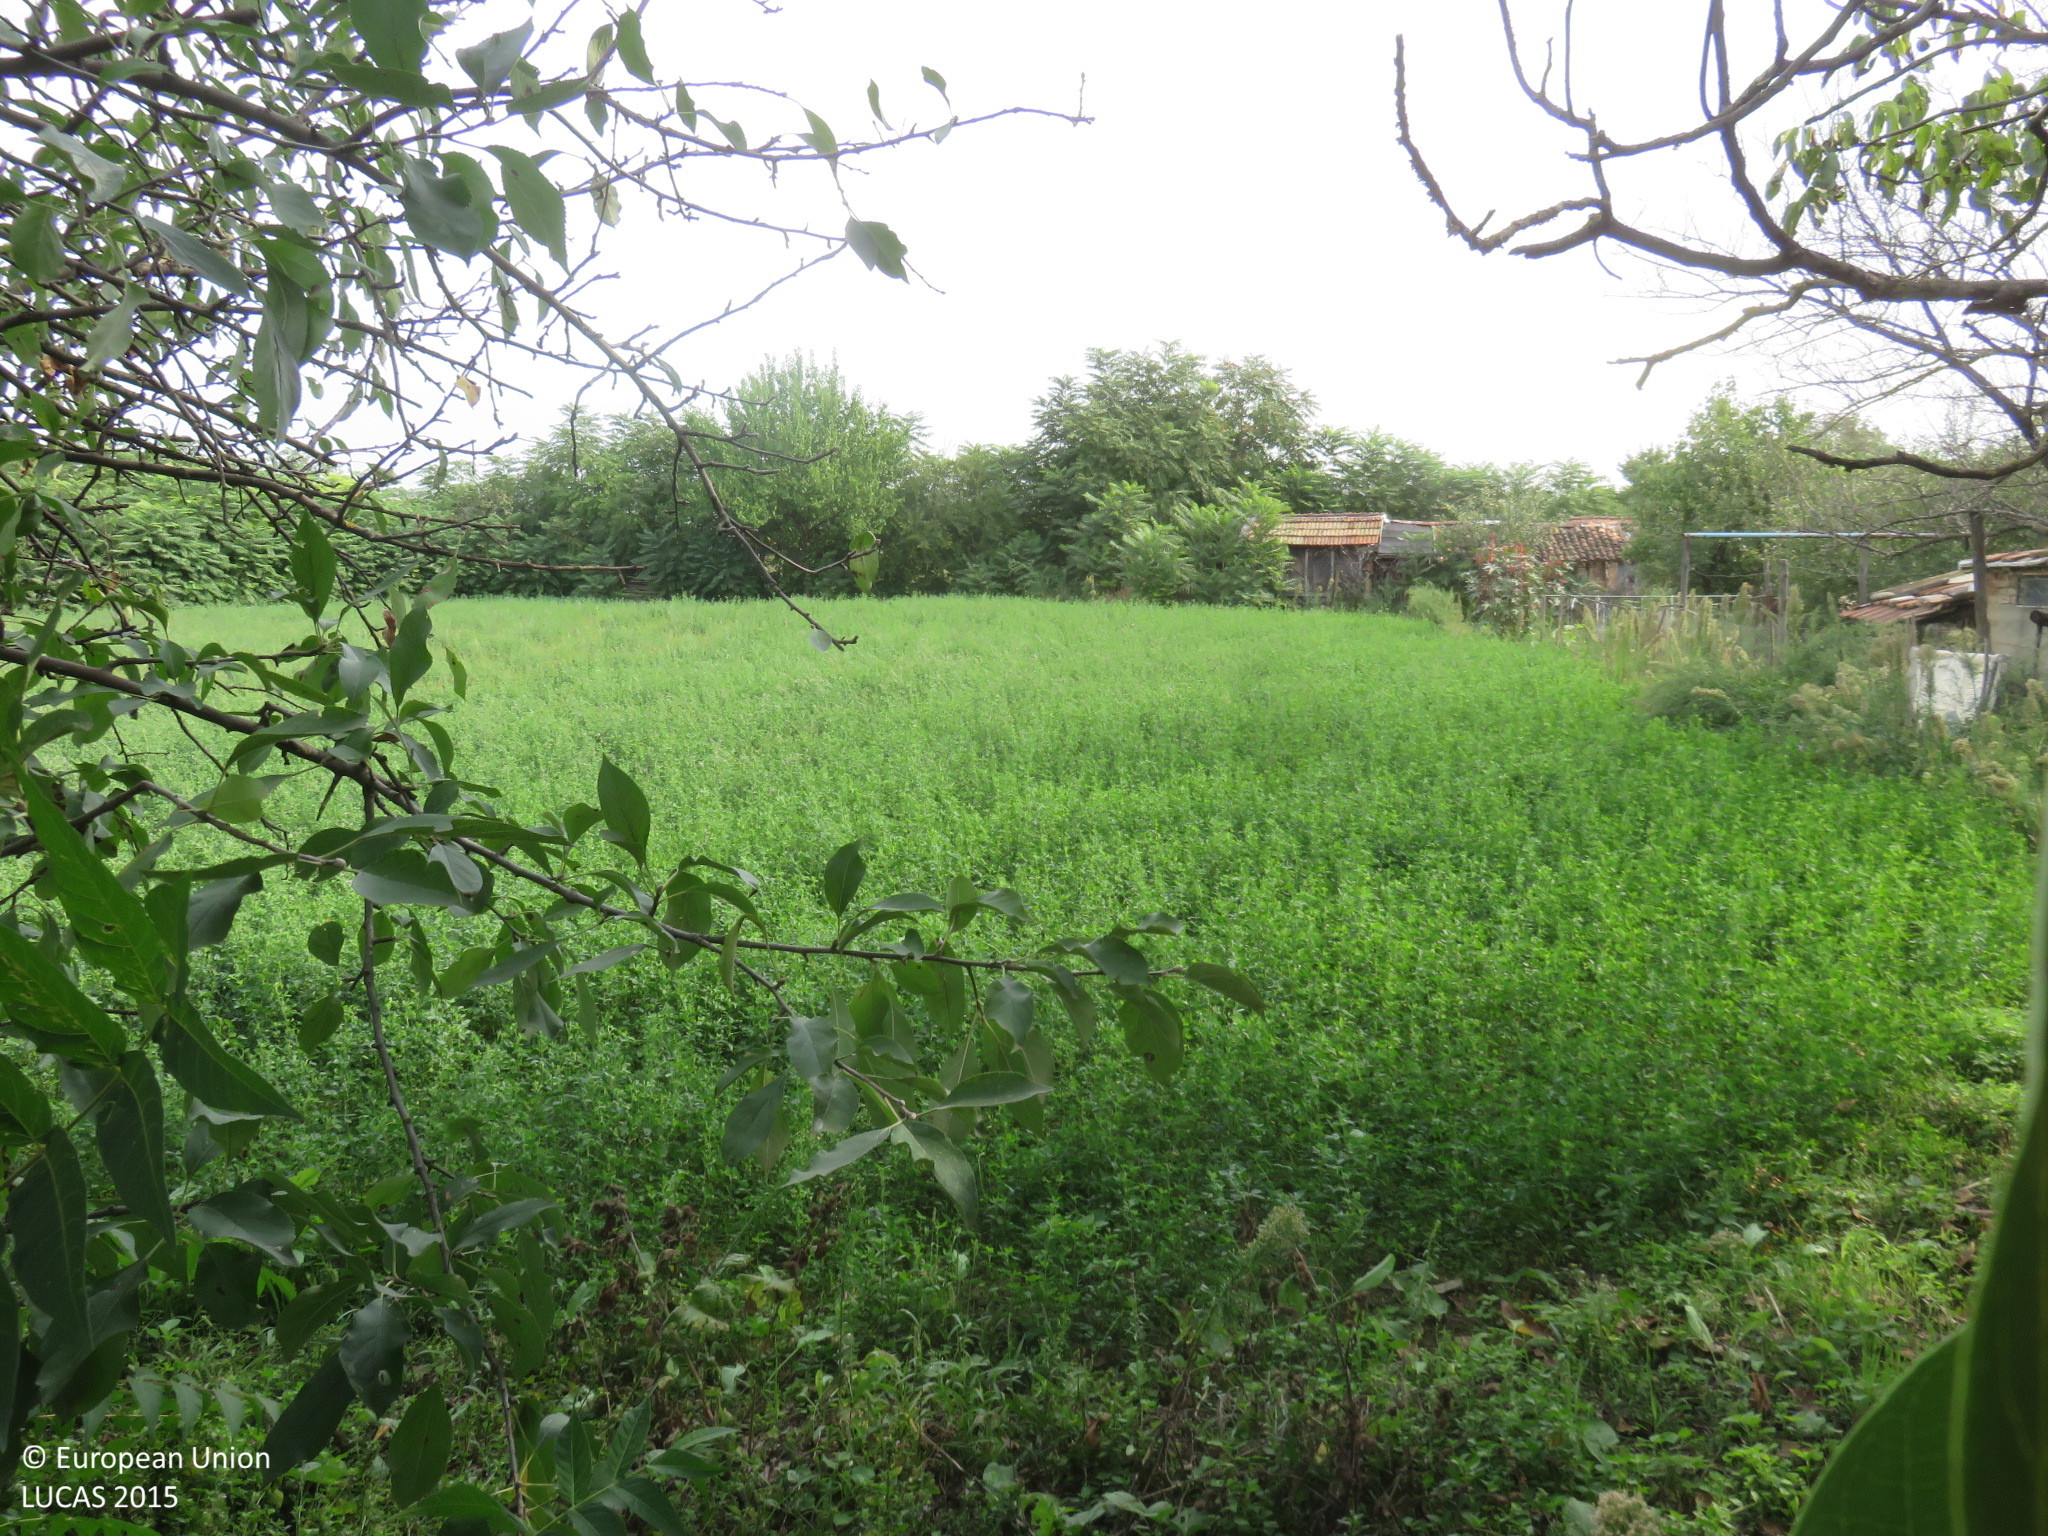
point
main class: Cropland
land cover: Lucerne
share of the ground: > 75 %
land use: Kitchen garden
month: September
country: BG
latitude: 43.5092
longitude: 25.0011
